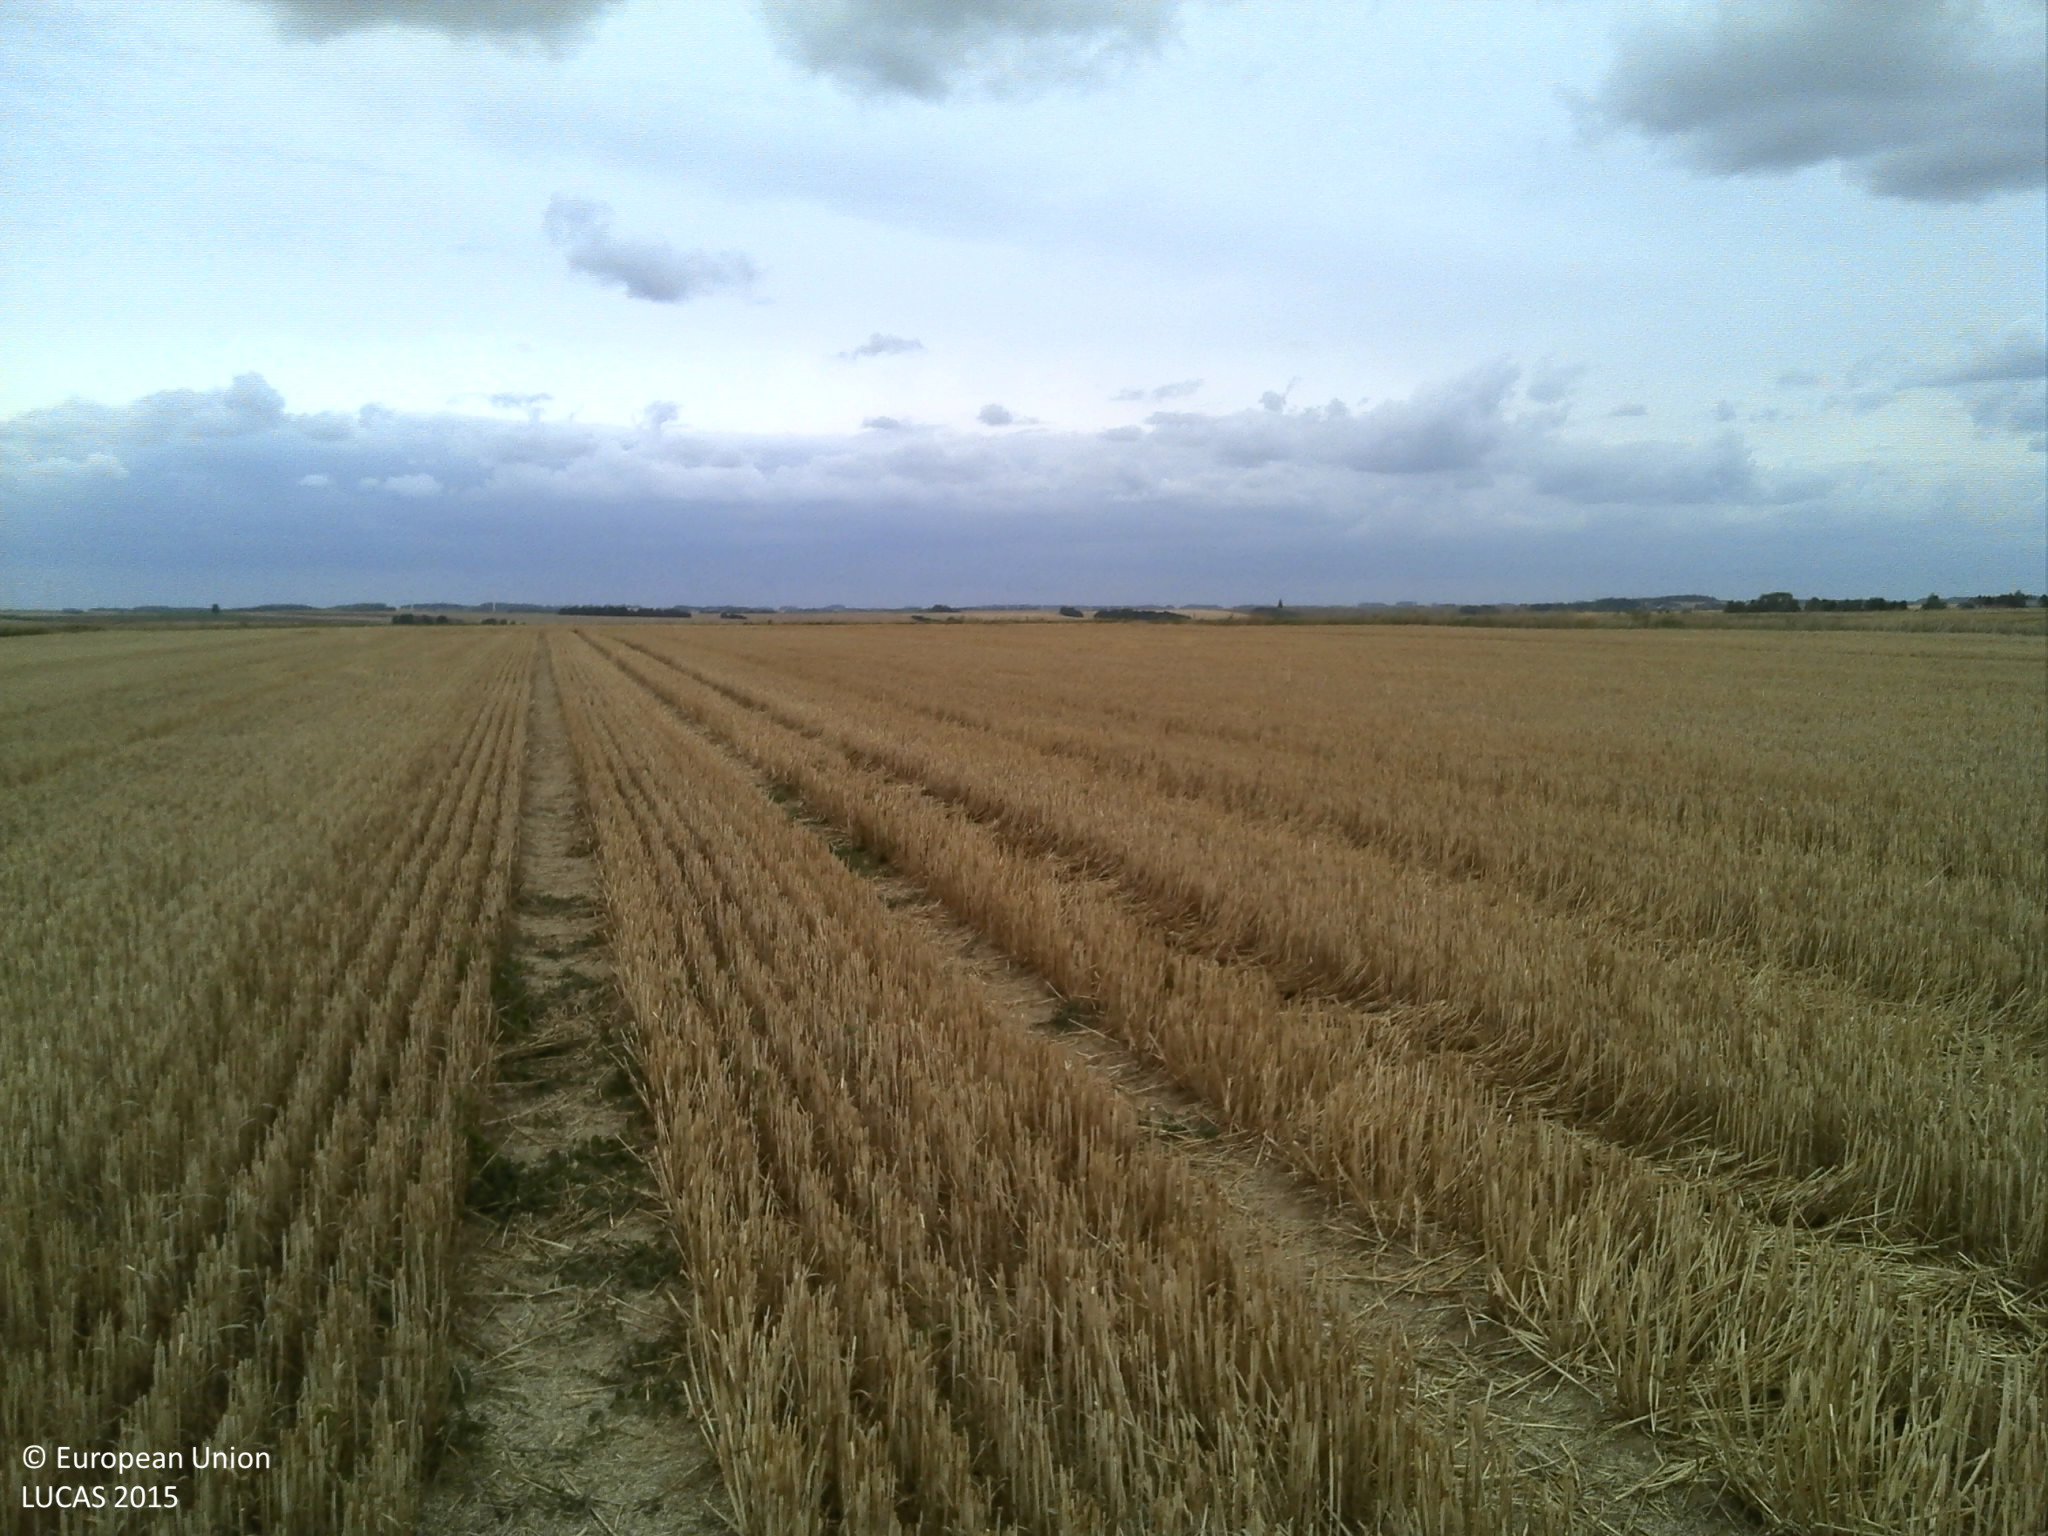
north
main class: Cropland
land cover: Common wheat
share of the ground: 50 - 75 %
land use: Agriculture (excluding fallow land and kitchen gardens)
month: July
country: FR
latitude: 49.5637
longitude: 4.1190
